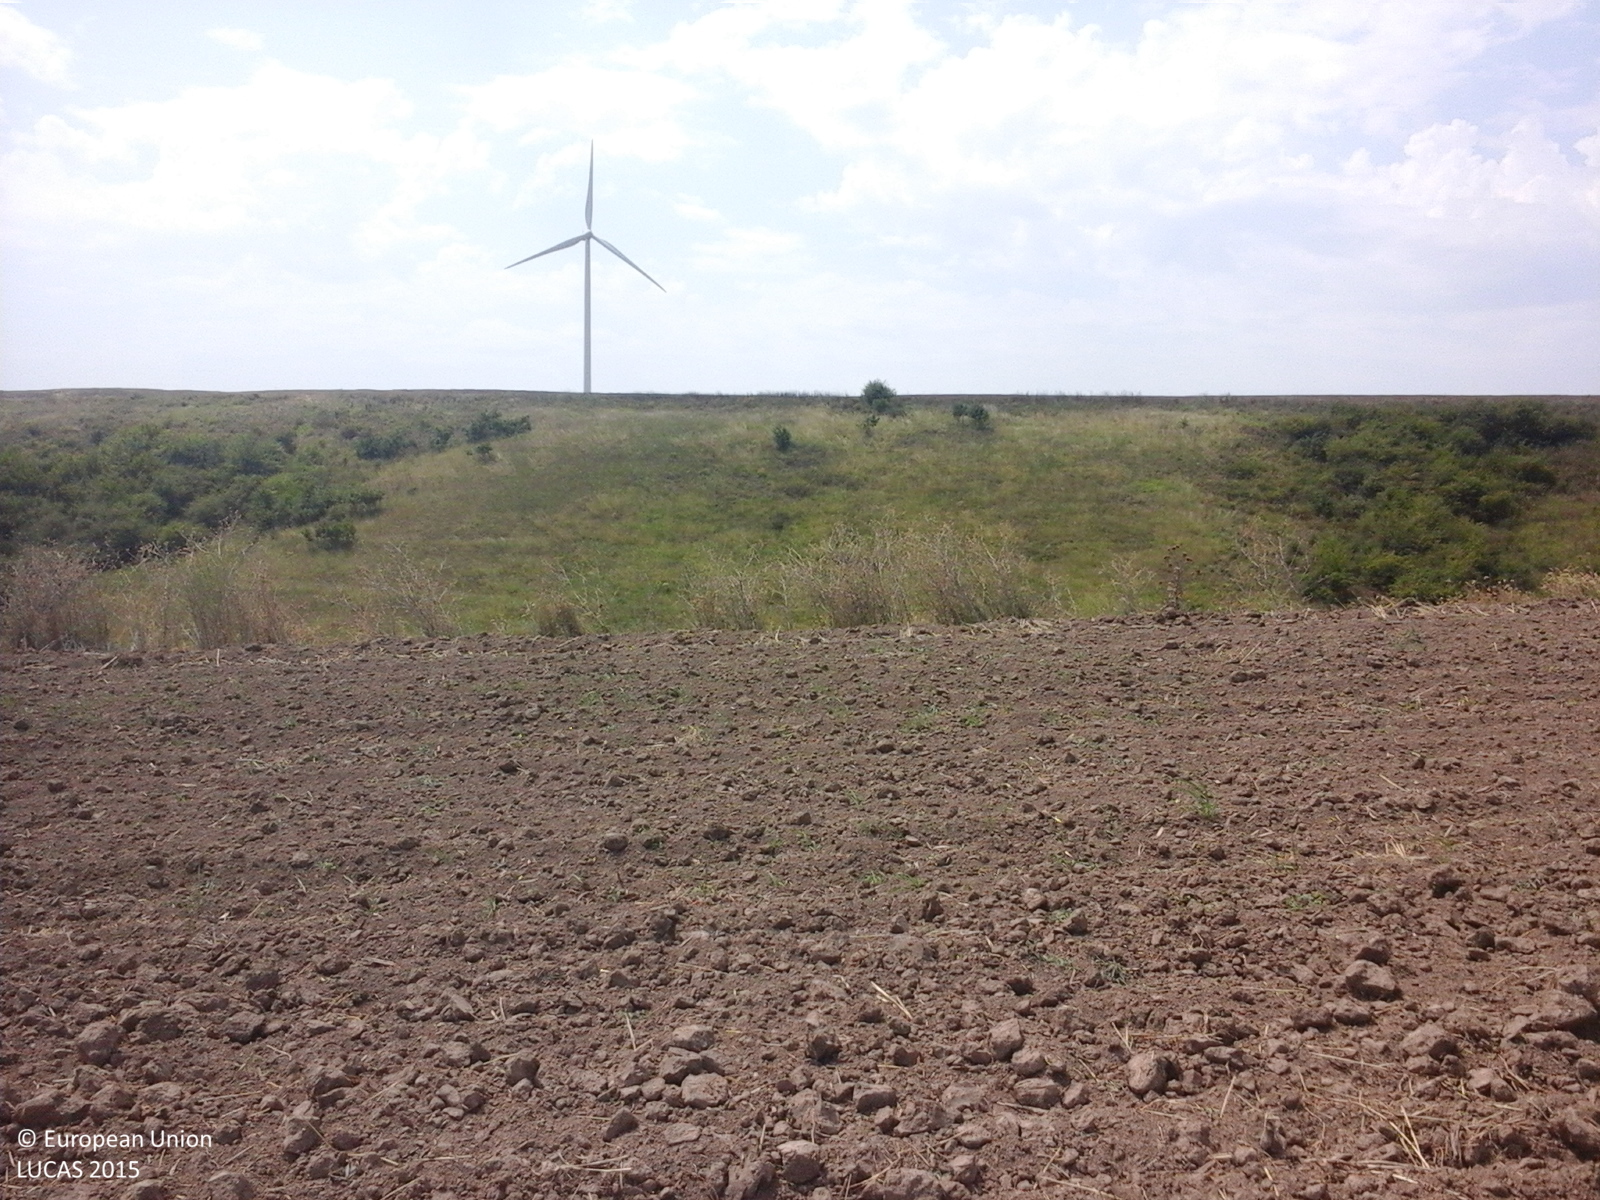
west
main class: Cropland
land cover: Common wheat
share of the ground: < 10 %
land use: Agriculture (excluding fallow land and kitchen gardens)
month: August
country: RO
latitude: 44.2149
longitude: 28.0155
